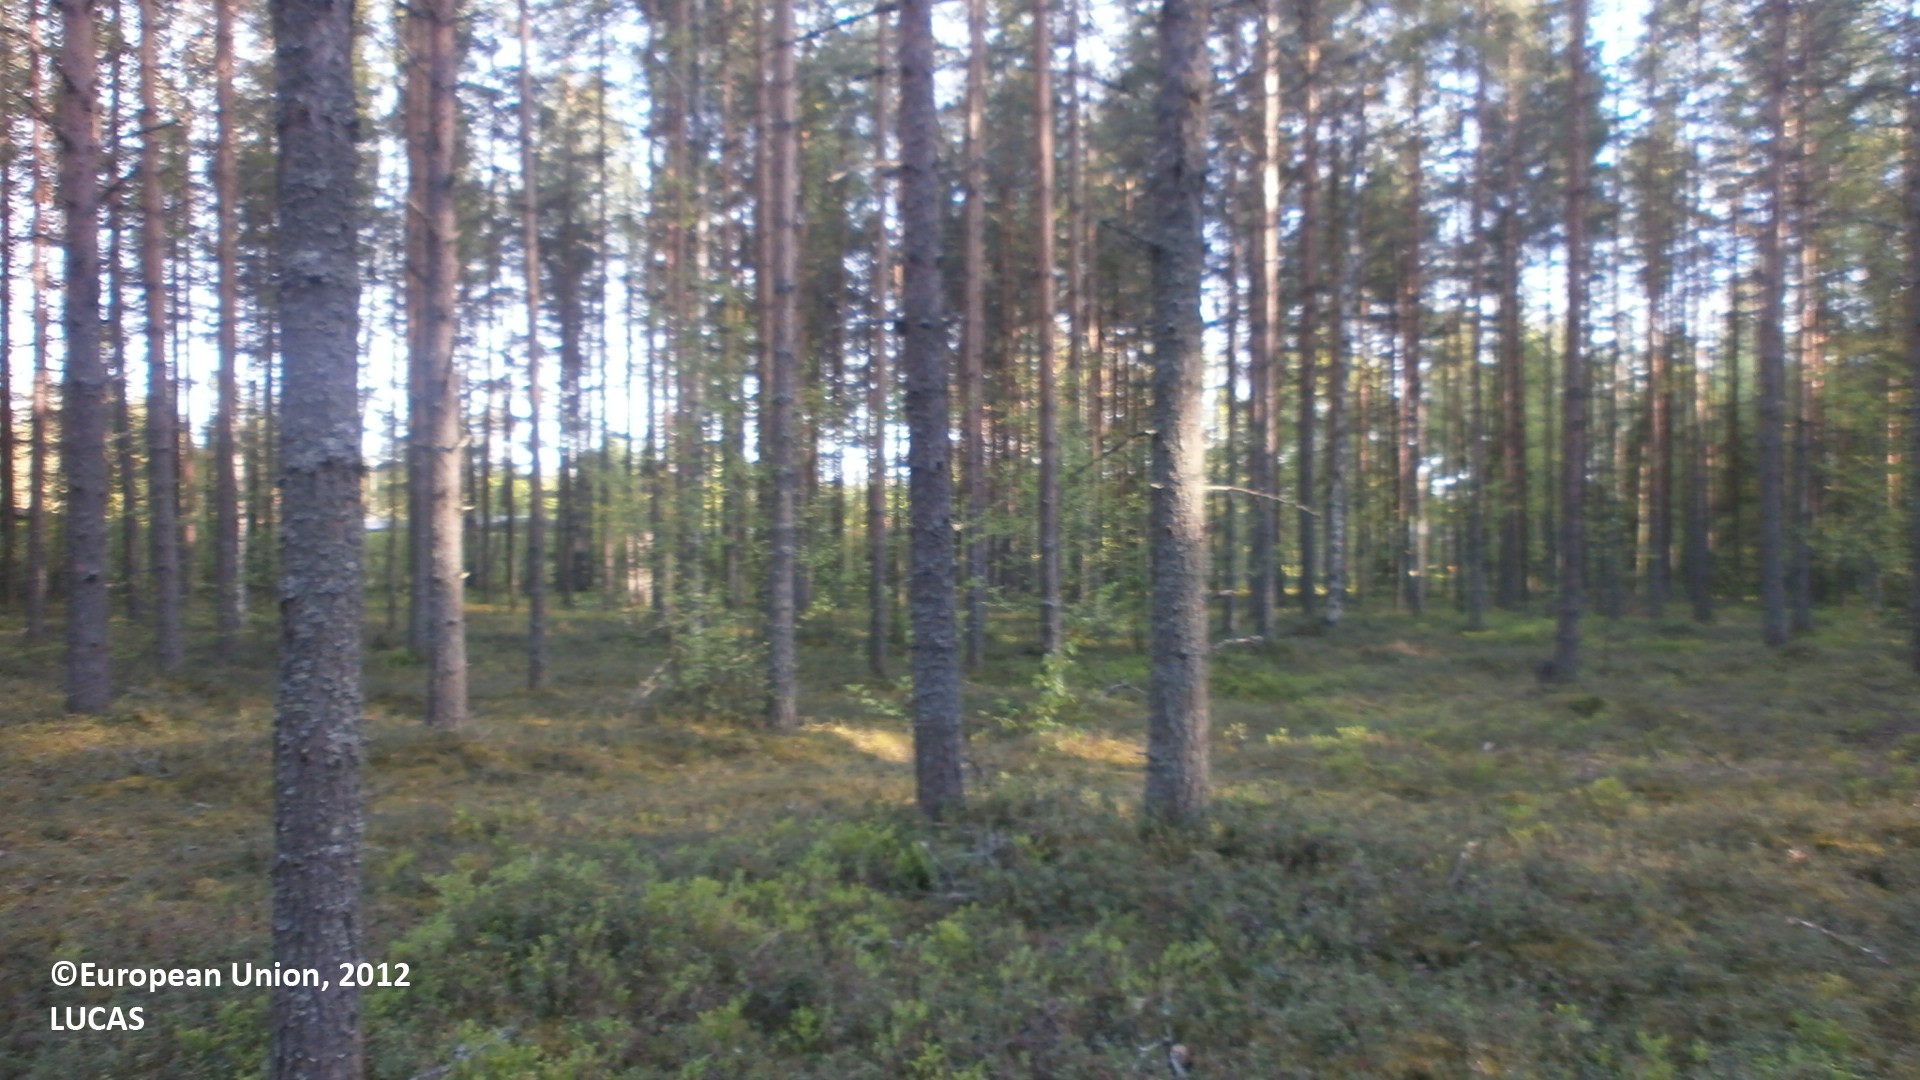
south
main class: Woodland
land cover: Pine dominated coniferous woodland
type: hemiboreal forest and nemoral coniferous forest and mixed broadleaved-coniferous forest
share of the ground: 50 - 75 %
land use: Semi-natural and natural areas not in use
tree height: > 5 m
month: June
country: FI
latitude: 64.4915
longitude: 25.0014
